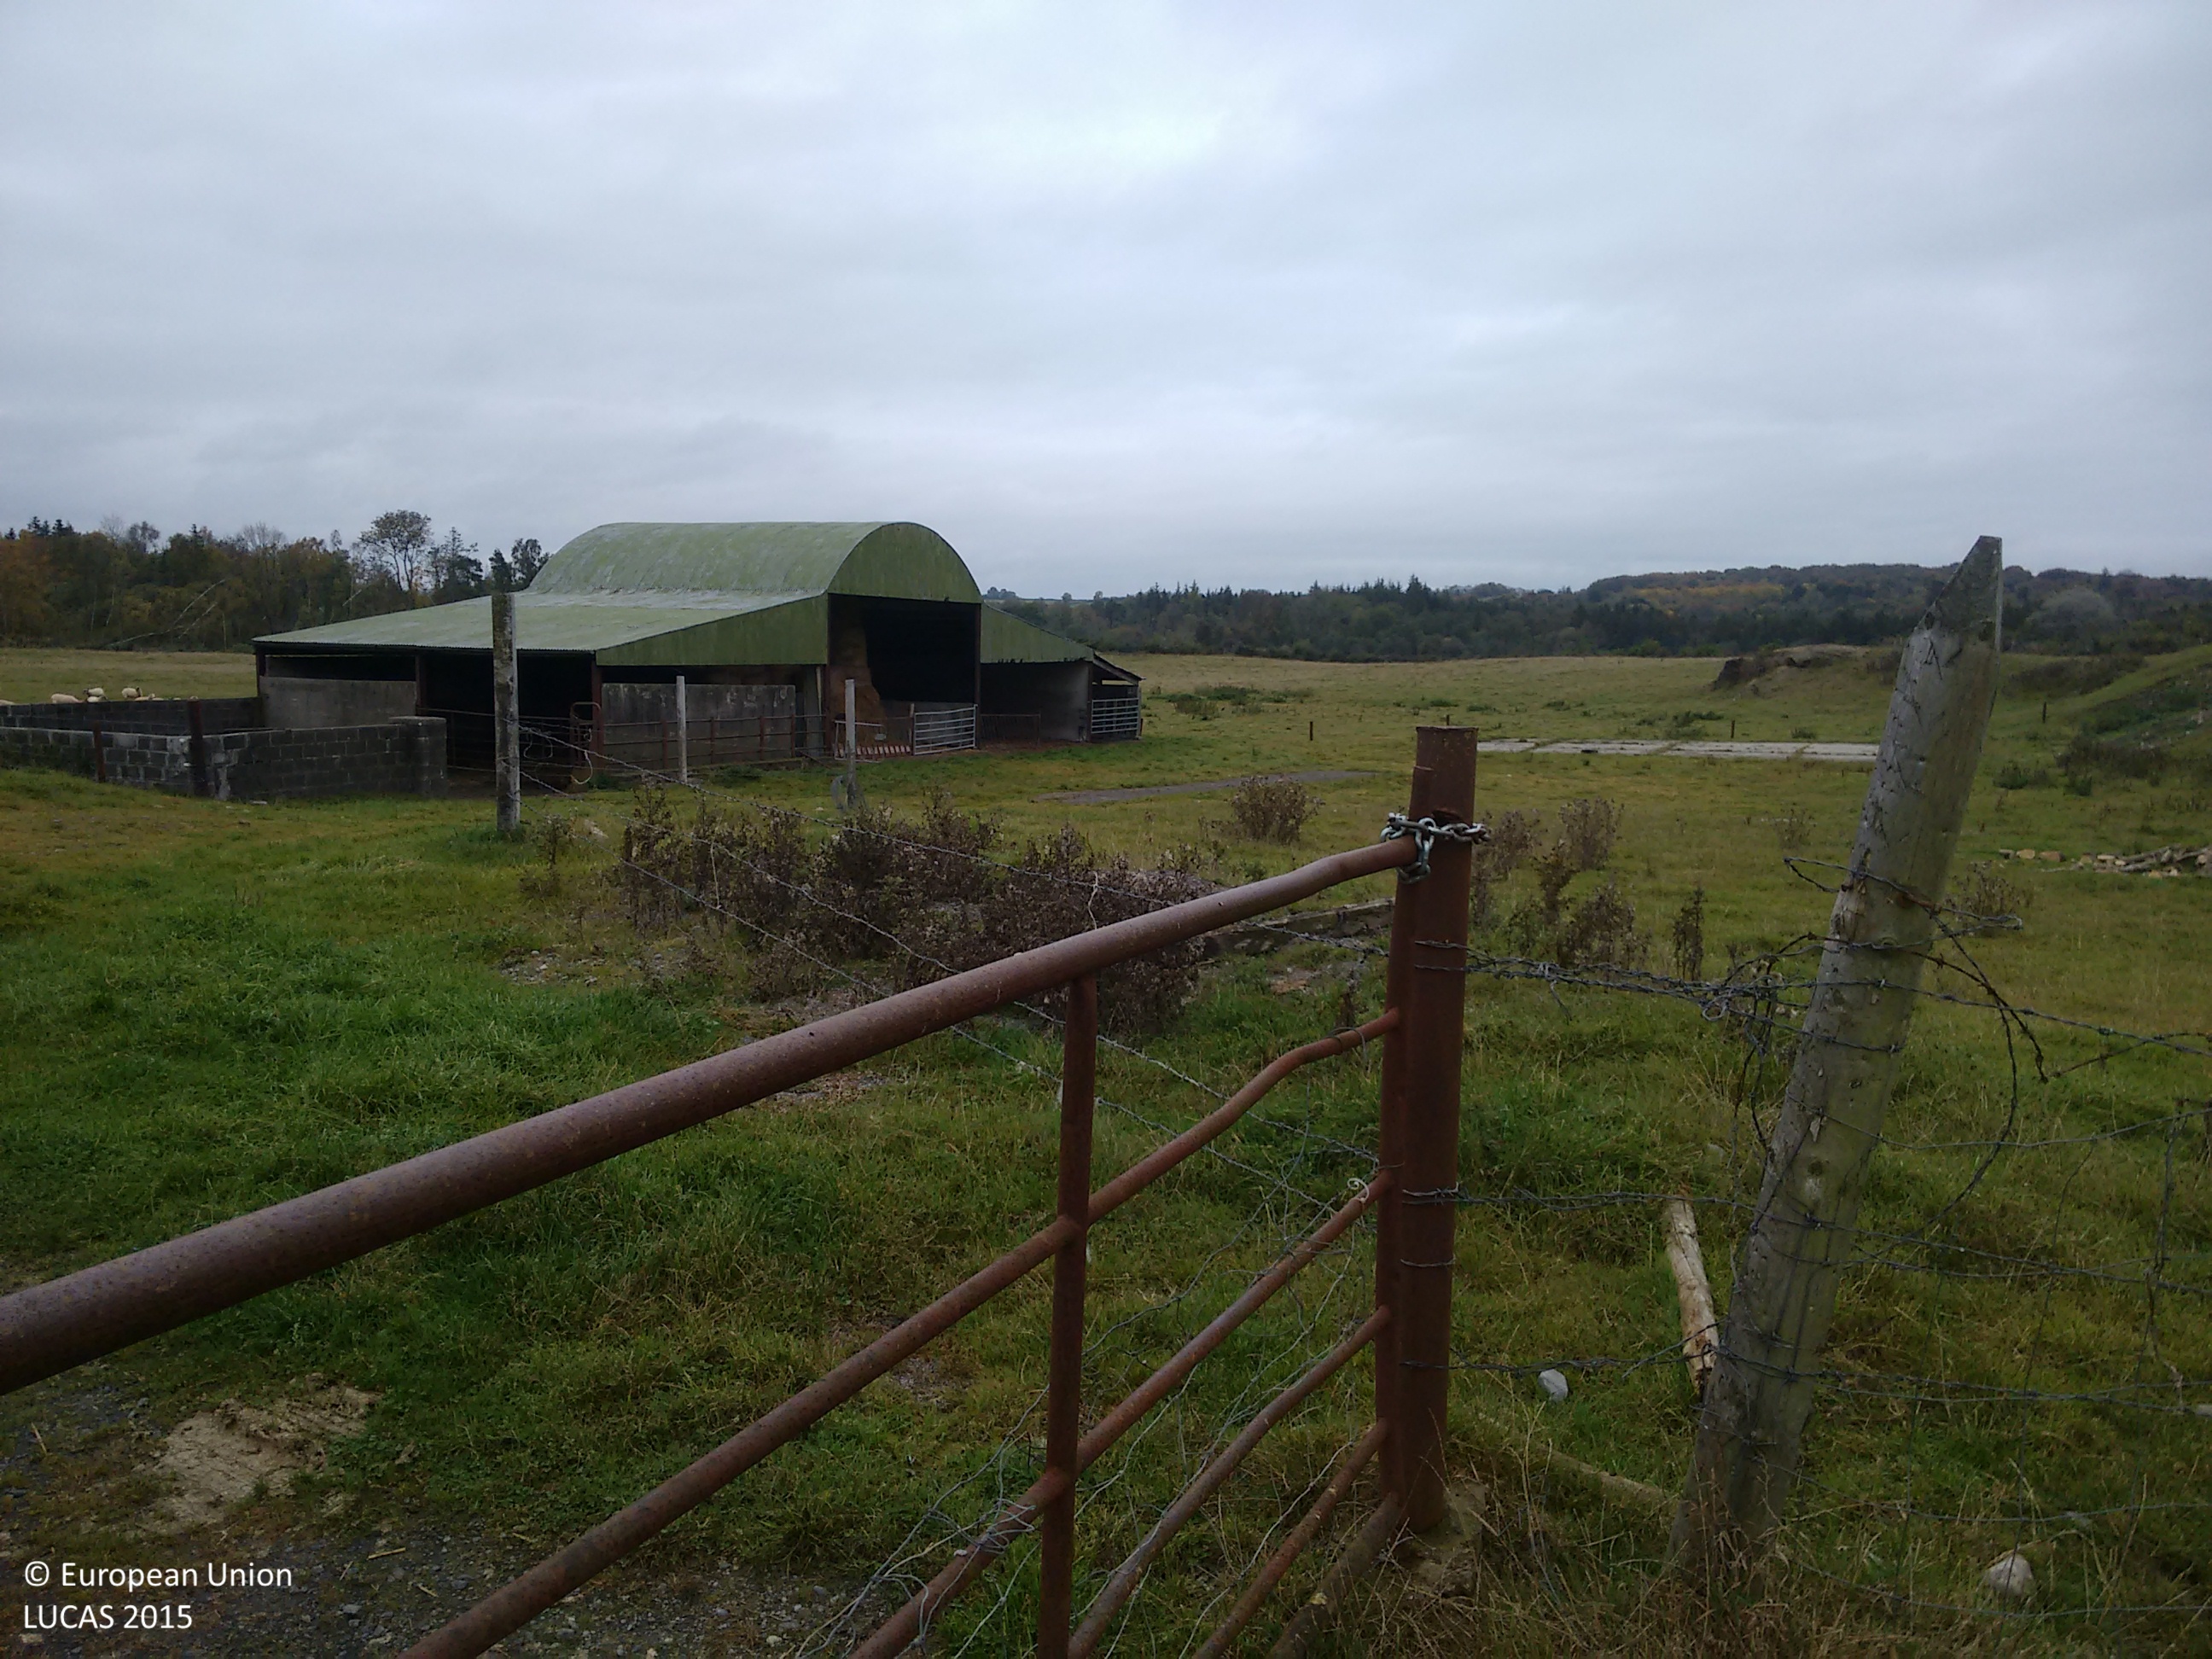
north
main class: Grassland
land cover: Grassland without tree/shrub cover
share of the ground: > 75 %
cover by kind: herbaceous plants 100 %
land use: Agriculture (excluding fallow land and kitchen gardens)
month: October
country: IE
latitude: 52.9946
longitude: -7.8863
